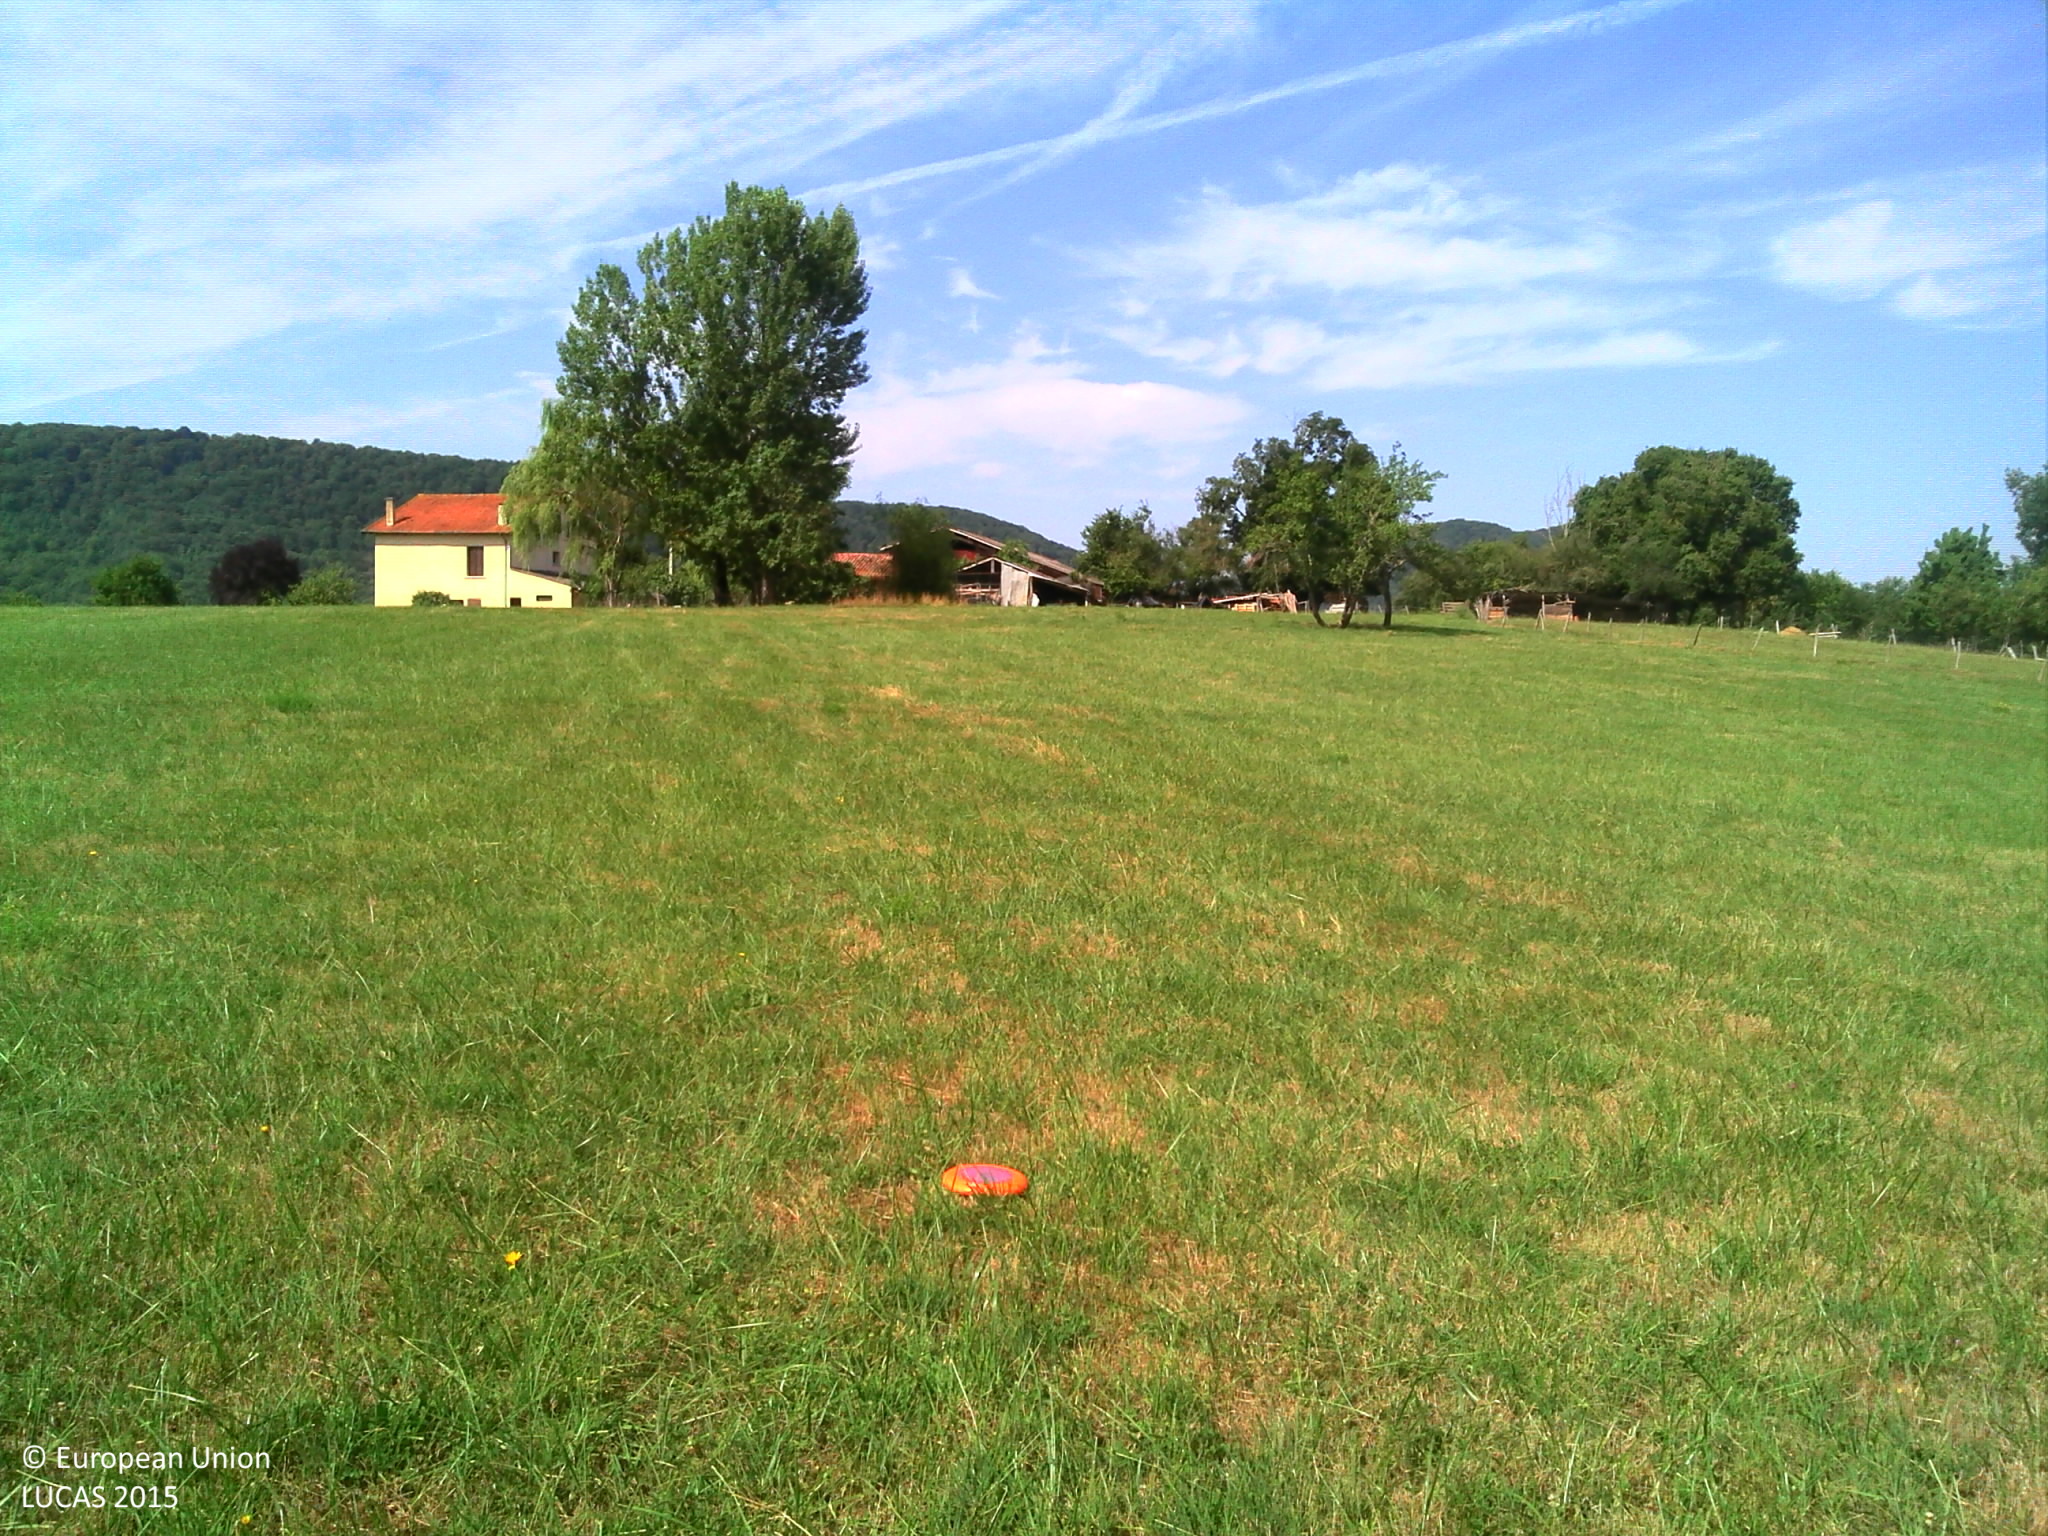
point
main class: Grassland
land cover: Grassland without tree/shrub cover
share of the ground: > 75 %
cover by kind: herbaceous plants 100 %
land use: Agriculture (excluding fallow land and kitchen gardens)
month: July
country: FR
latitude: 43.1658
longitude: 1.0613
